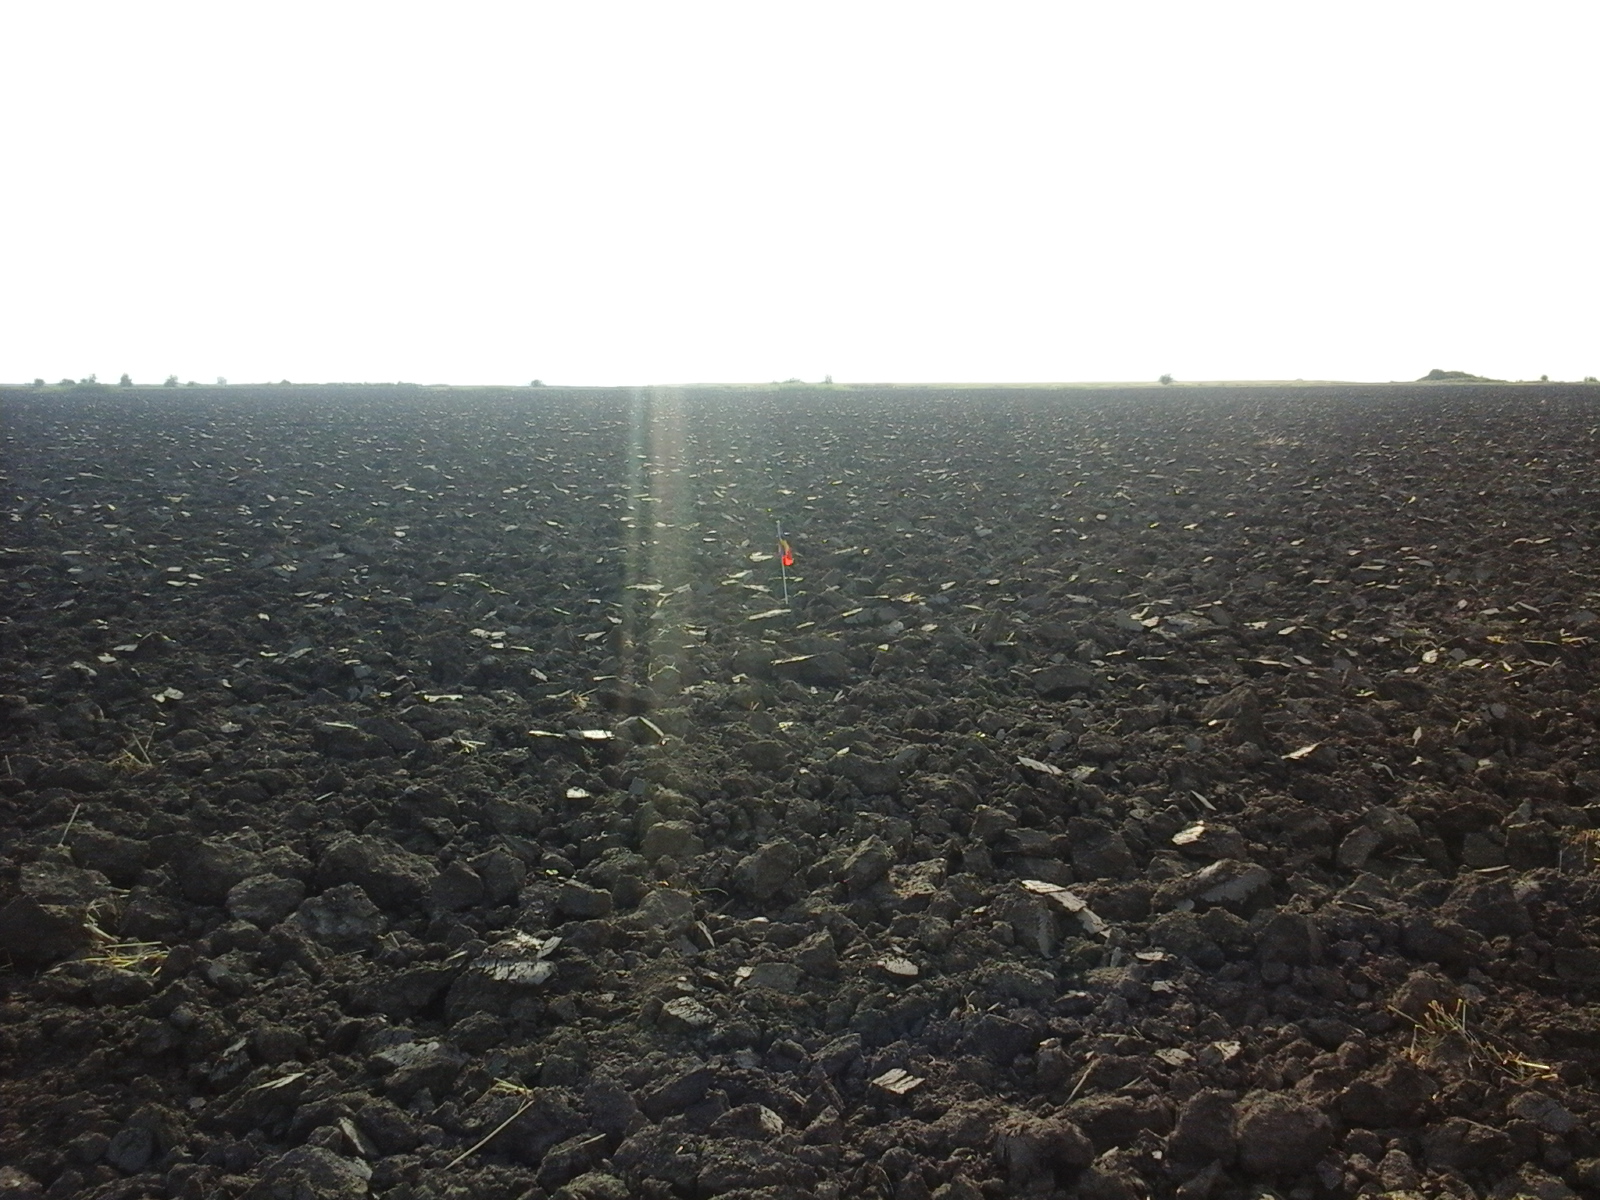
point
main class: Cropland
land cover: Common wheat
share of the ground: < 10 %
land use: Agriculture (excluding fallow land and kitchen gardens)
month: August
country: RO
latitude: 43.9366
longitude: 23.5155
